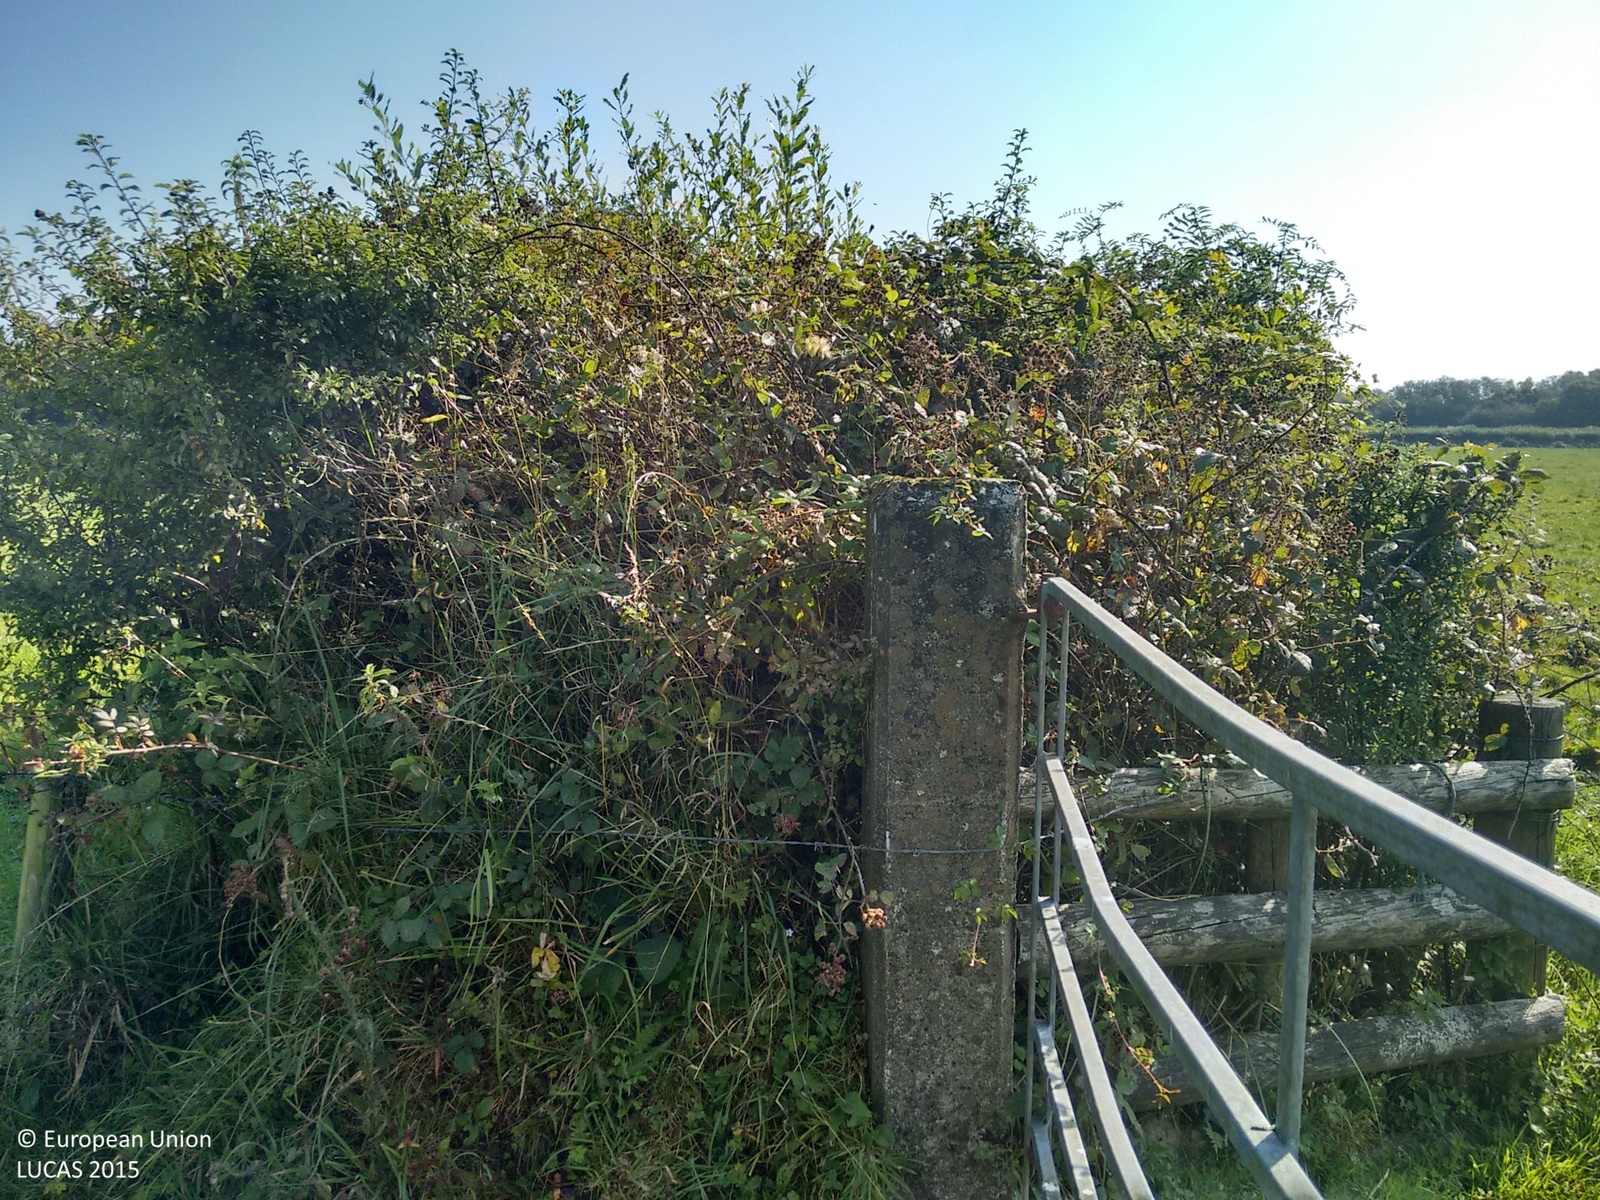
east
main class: Grassland
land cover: Grassland without tree/shrub cover
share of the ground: > 75 %
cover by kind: herbaceous plants 100 %
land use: Agriculture (excluding fallow land and kitchen gardens)
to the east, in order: Grassland without tree/shrub cover; Fences; Managed hedges; Artificial constructions; Fences; Grassland without tree/shrub cover
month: September
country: GB
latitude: 50.8351
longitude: -4.4014
